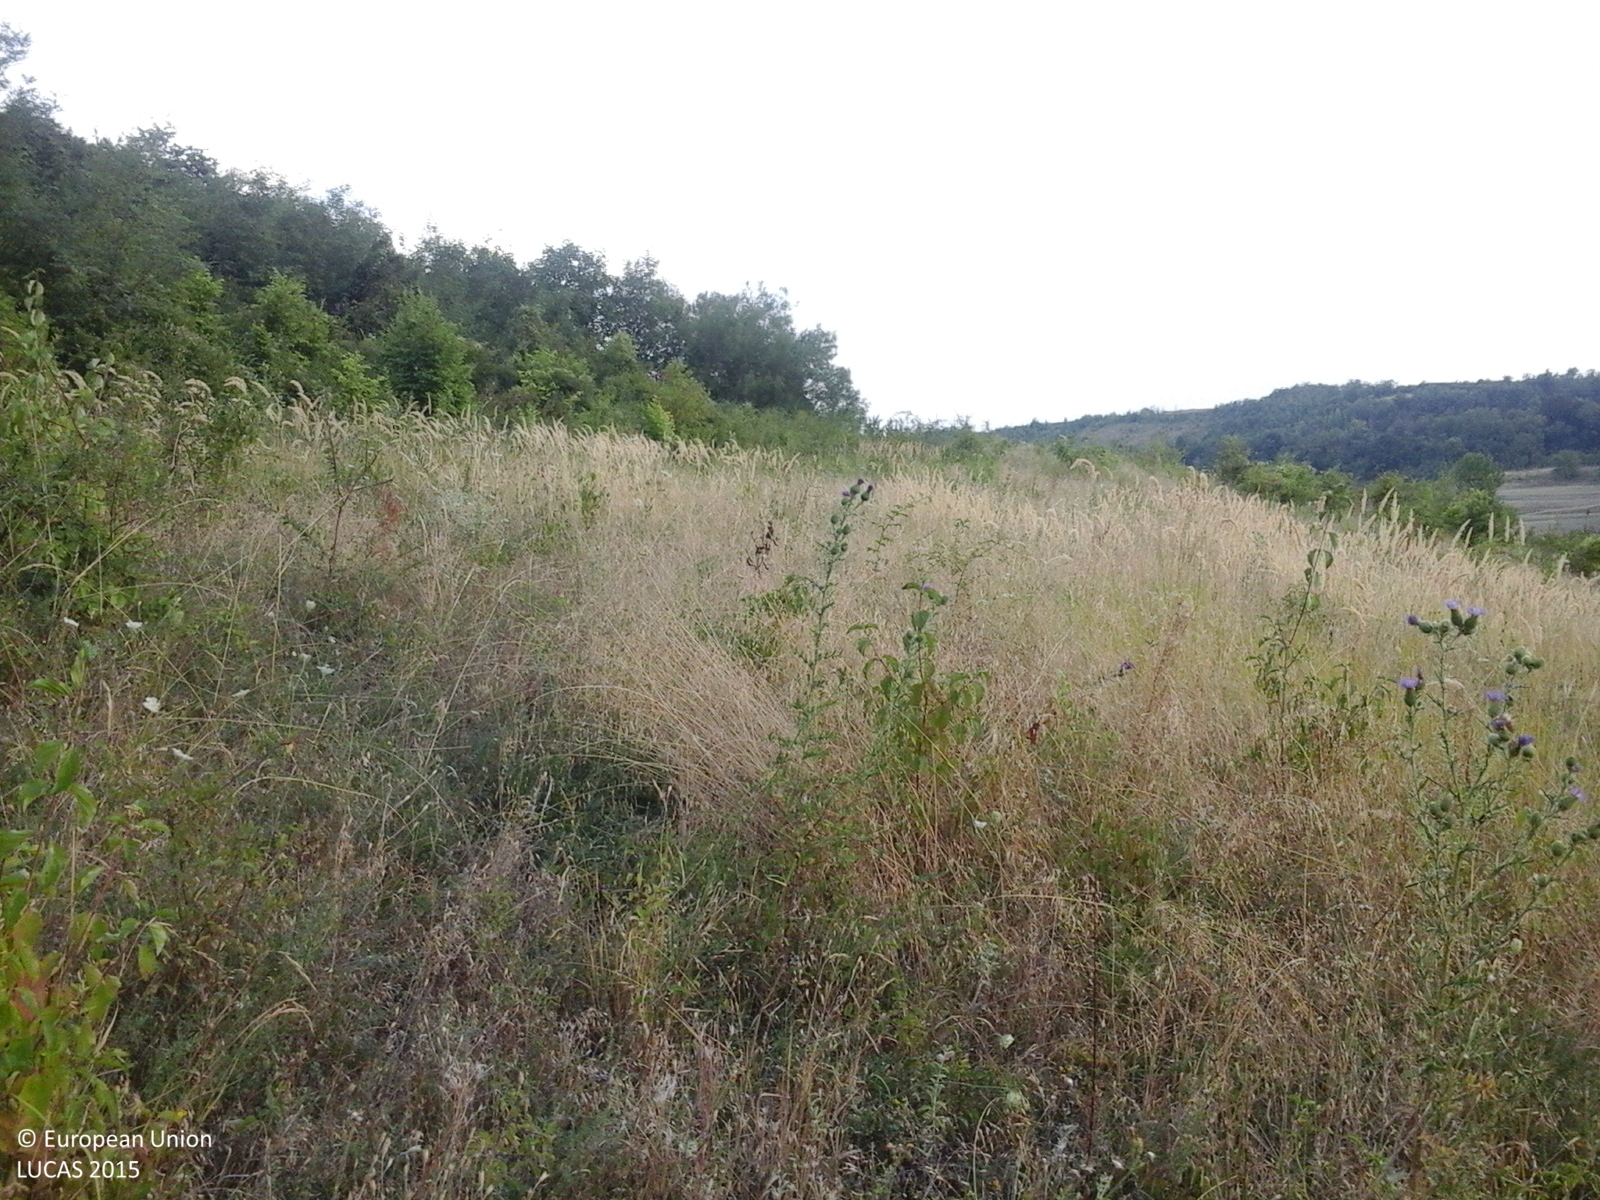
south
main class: Woodland
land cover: Broadleaved woodland
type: mesophytic deciduous forest
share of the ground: > 75 %
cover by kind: broadleaved forest trees 100 %
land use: Forestry
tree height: > 5 m
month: August
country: RO
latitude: 44.5655
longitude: 23.0278
